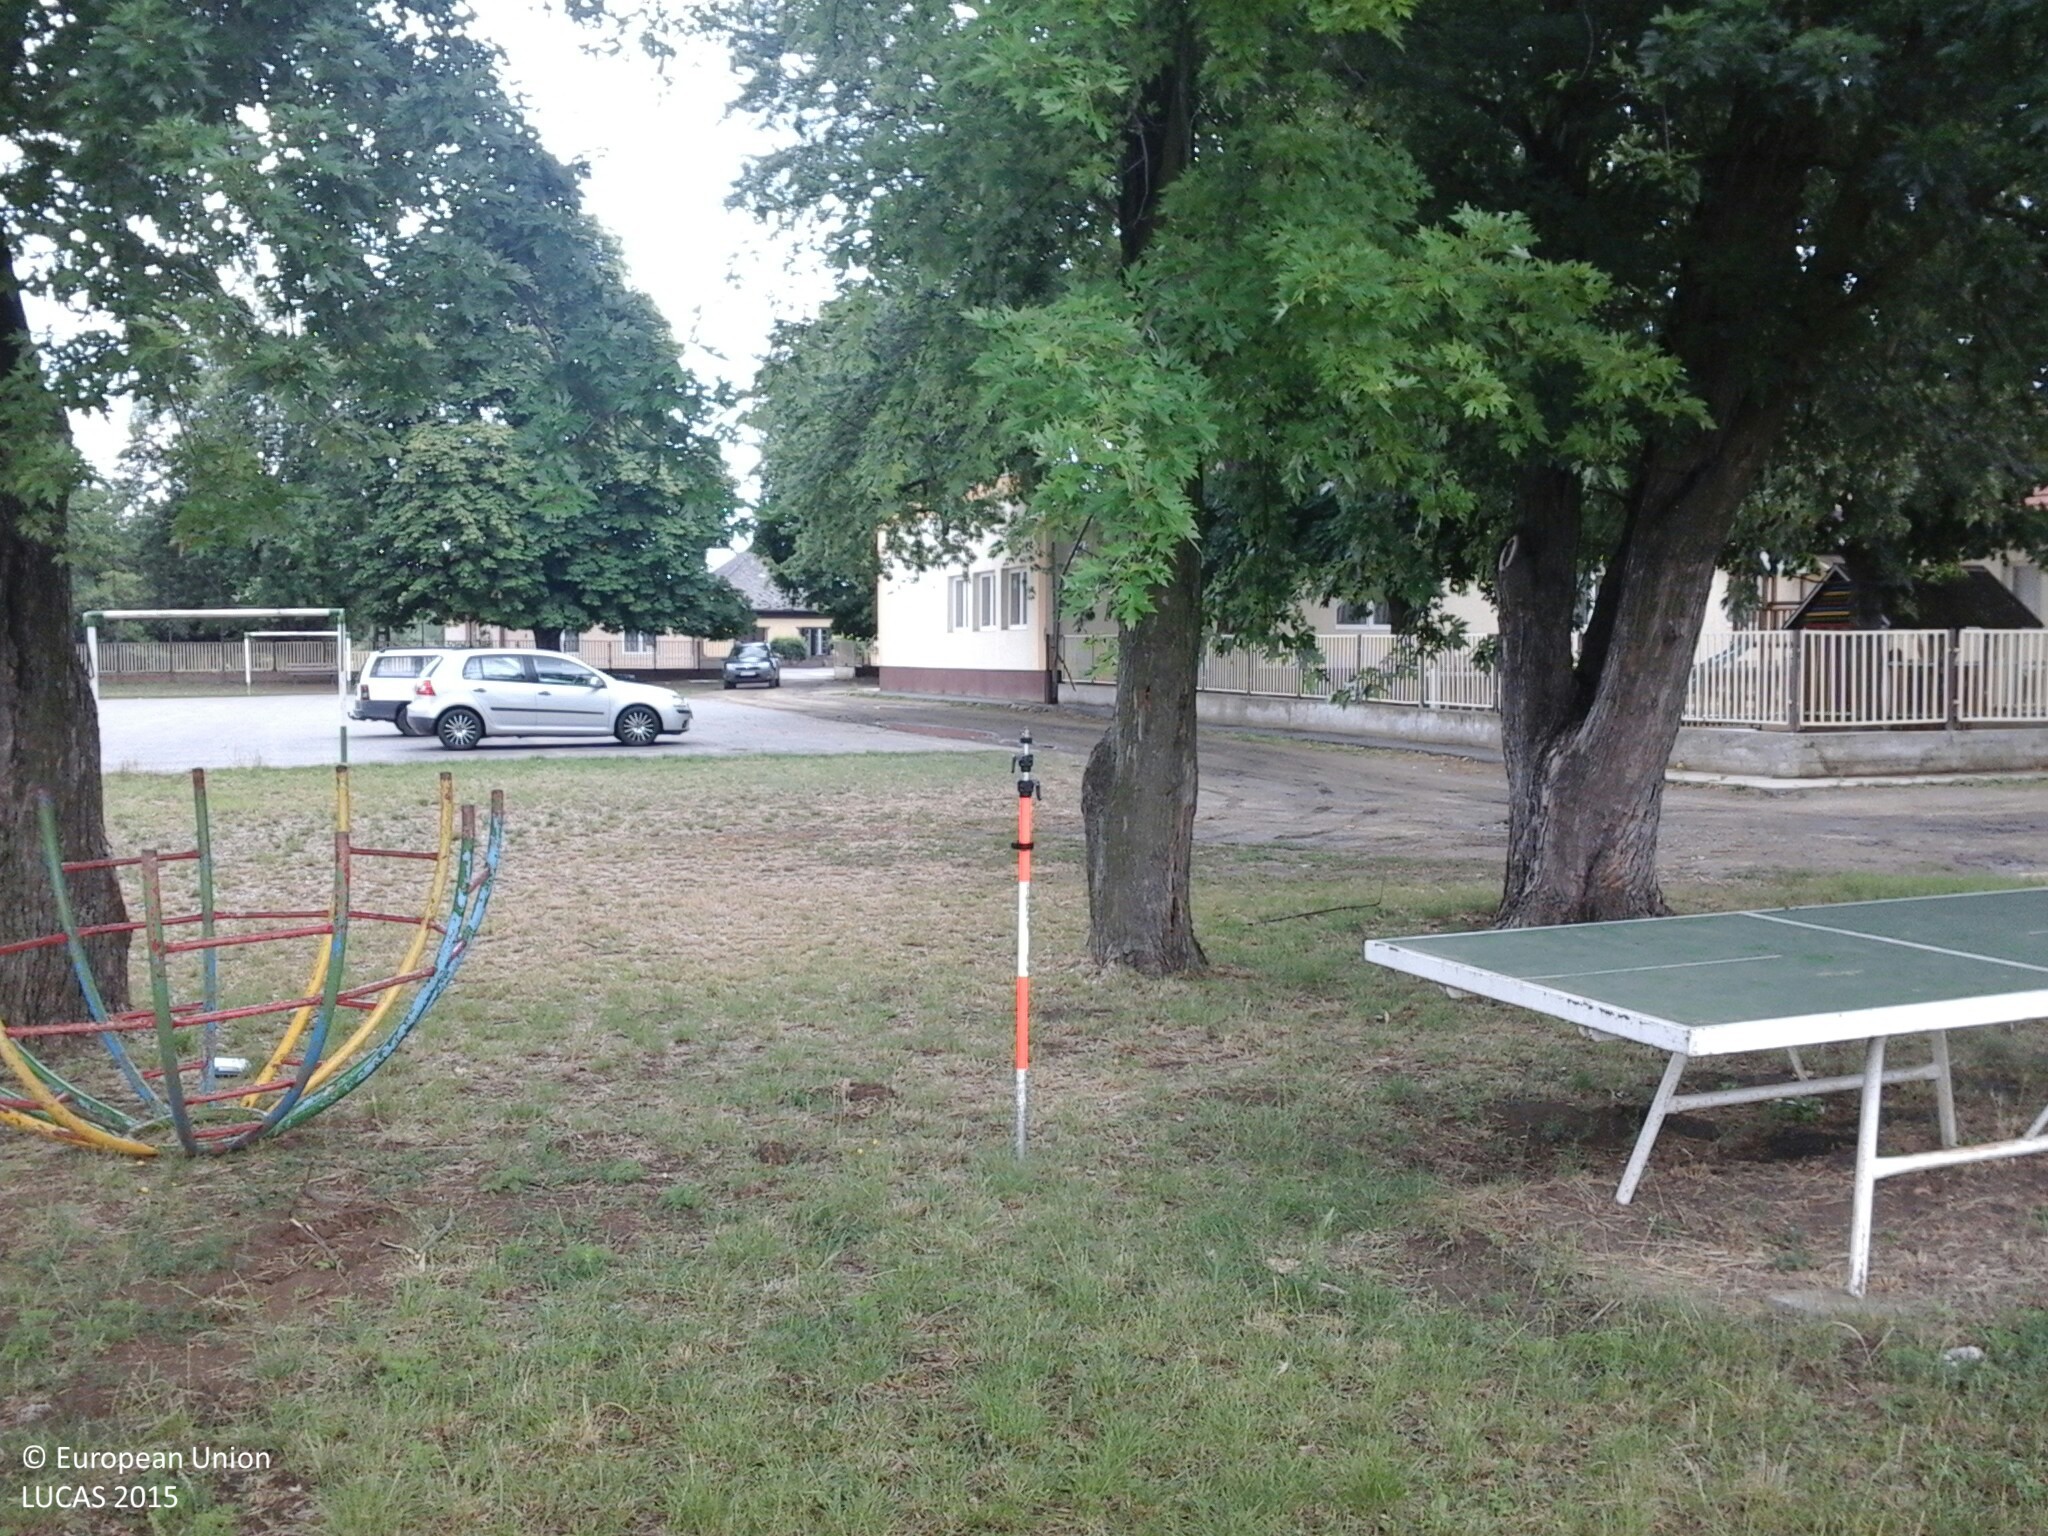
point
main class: Grassland
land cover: Grassland with sparse tree/shrub cover
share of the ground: > 75 %
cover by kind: herbaceous plants 95 %, broadleaved forest trees 5 %
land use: Amenities, museums, leisure
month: July
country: HU
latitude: 48.2005
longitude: 22.1782
